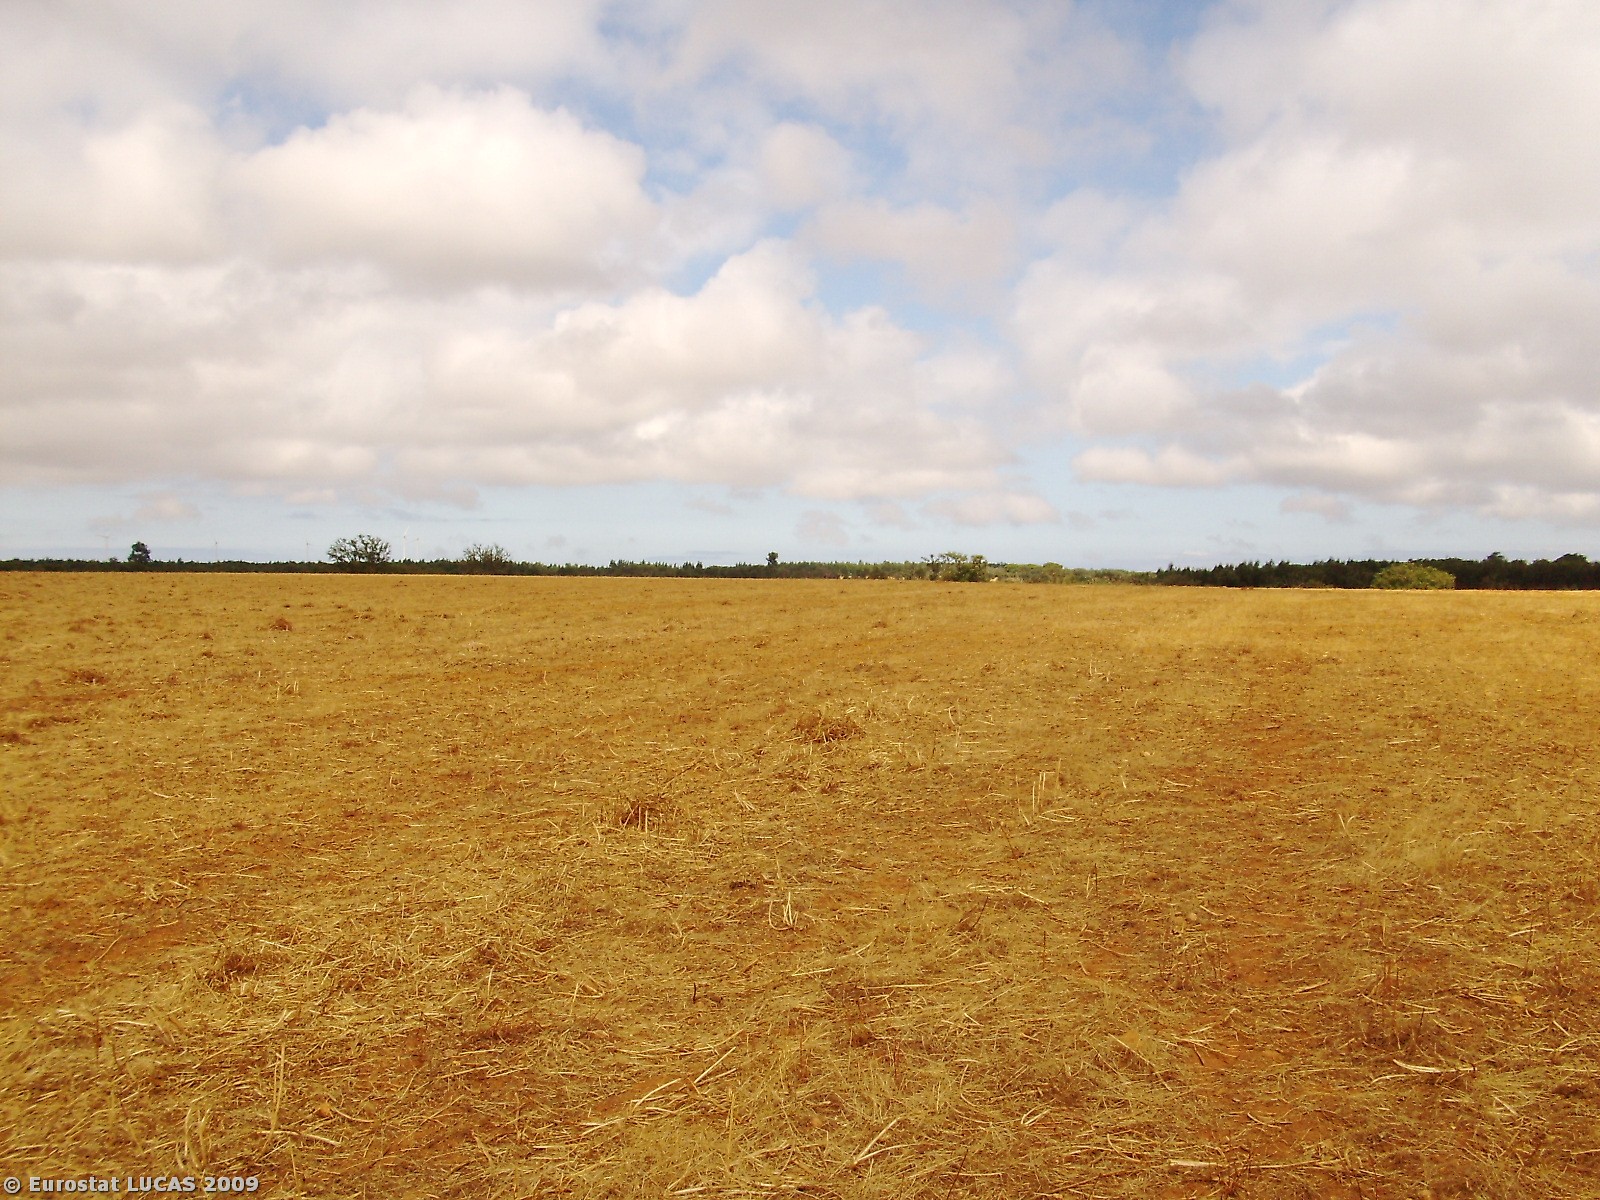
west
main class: Grassland
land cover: Spontaneously vegetated surfaces
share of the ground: > 75 %
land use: Fallow land
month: June
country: PT
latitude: 37.8634
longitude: -8.6750
